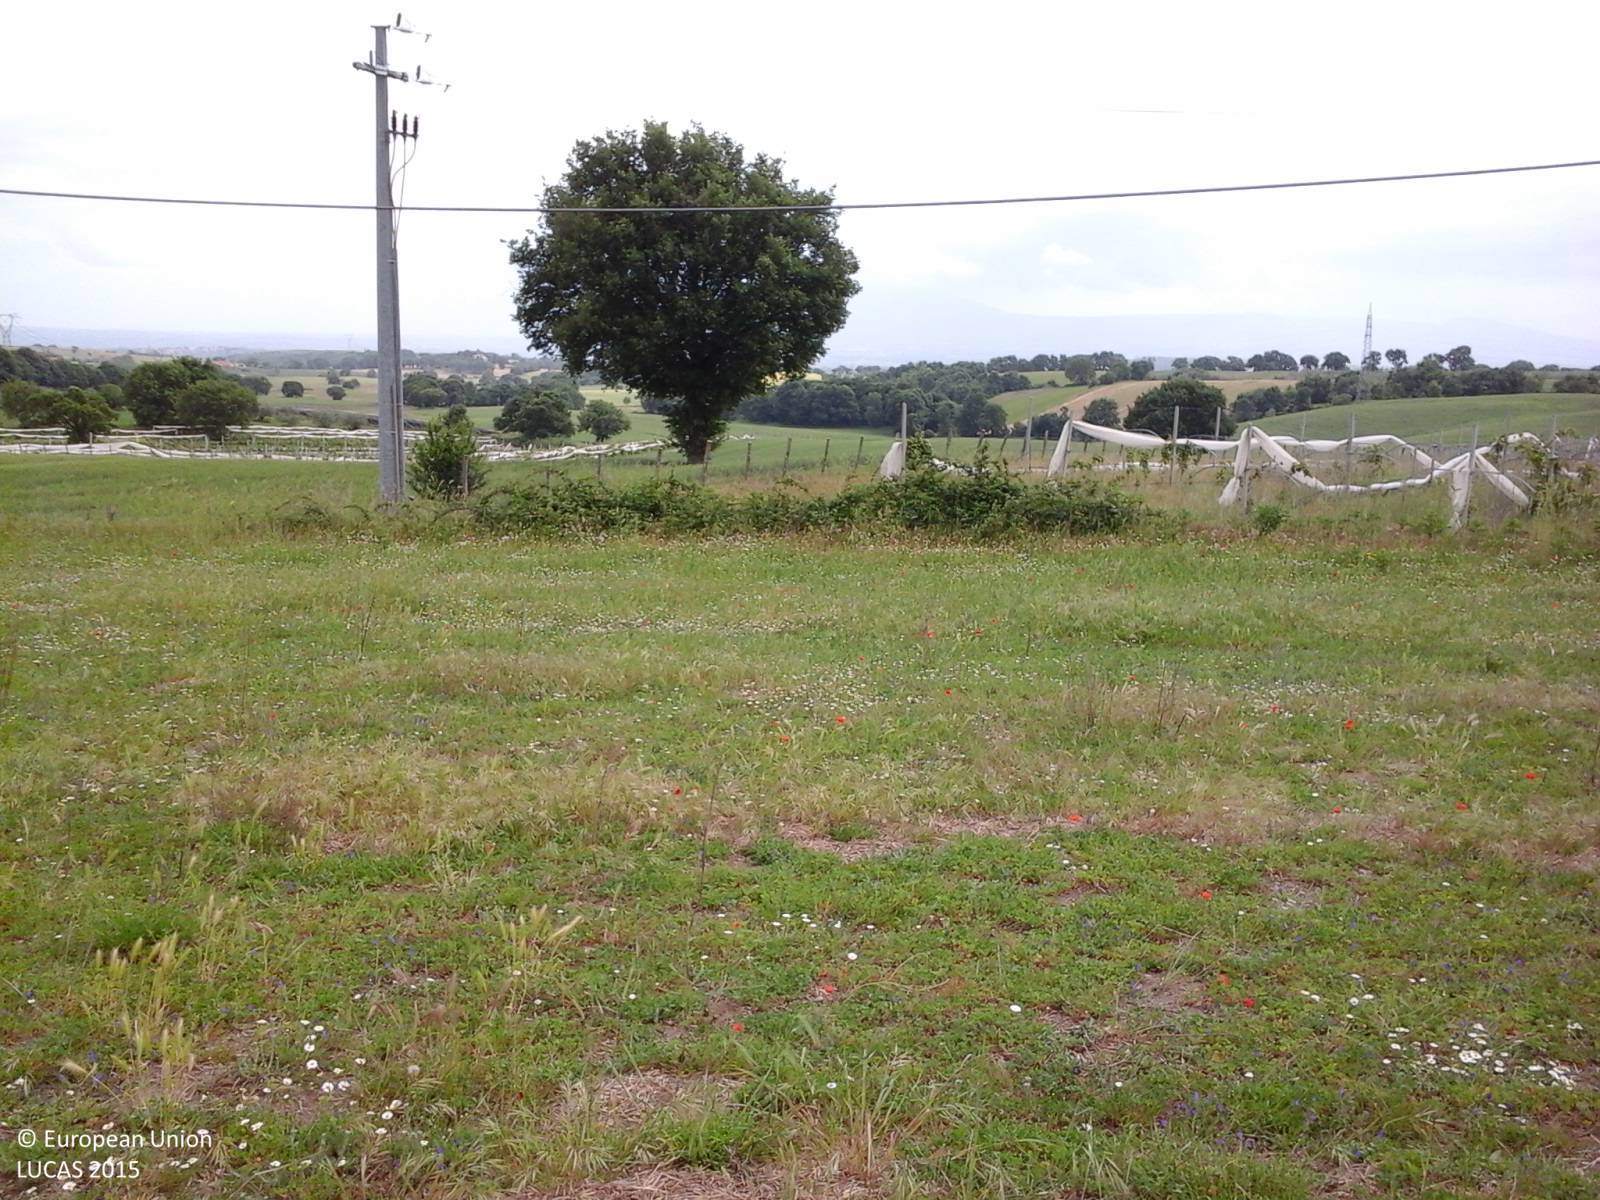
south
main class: Cropland
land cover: Lucerne
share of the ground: > 75 %
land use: Agriculture (excluding fallow land and kitchen gardens)
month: May
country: IT
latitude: 42.5600
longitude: 12.1002
